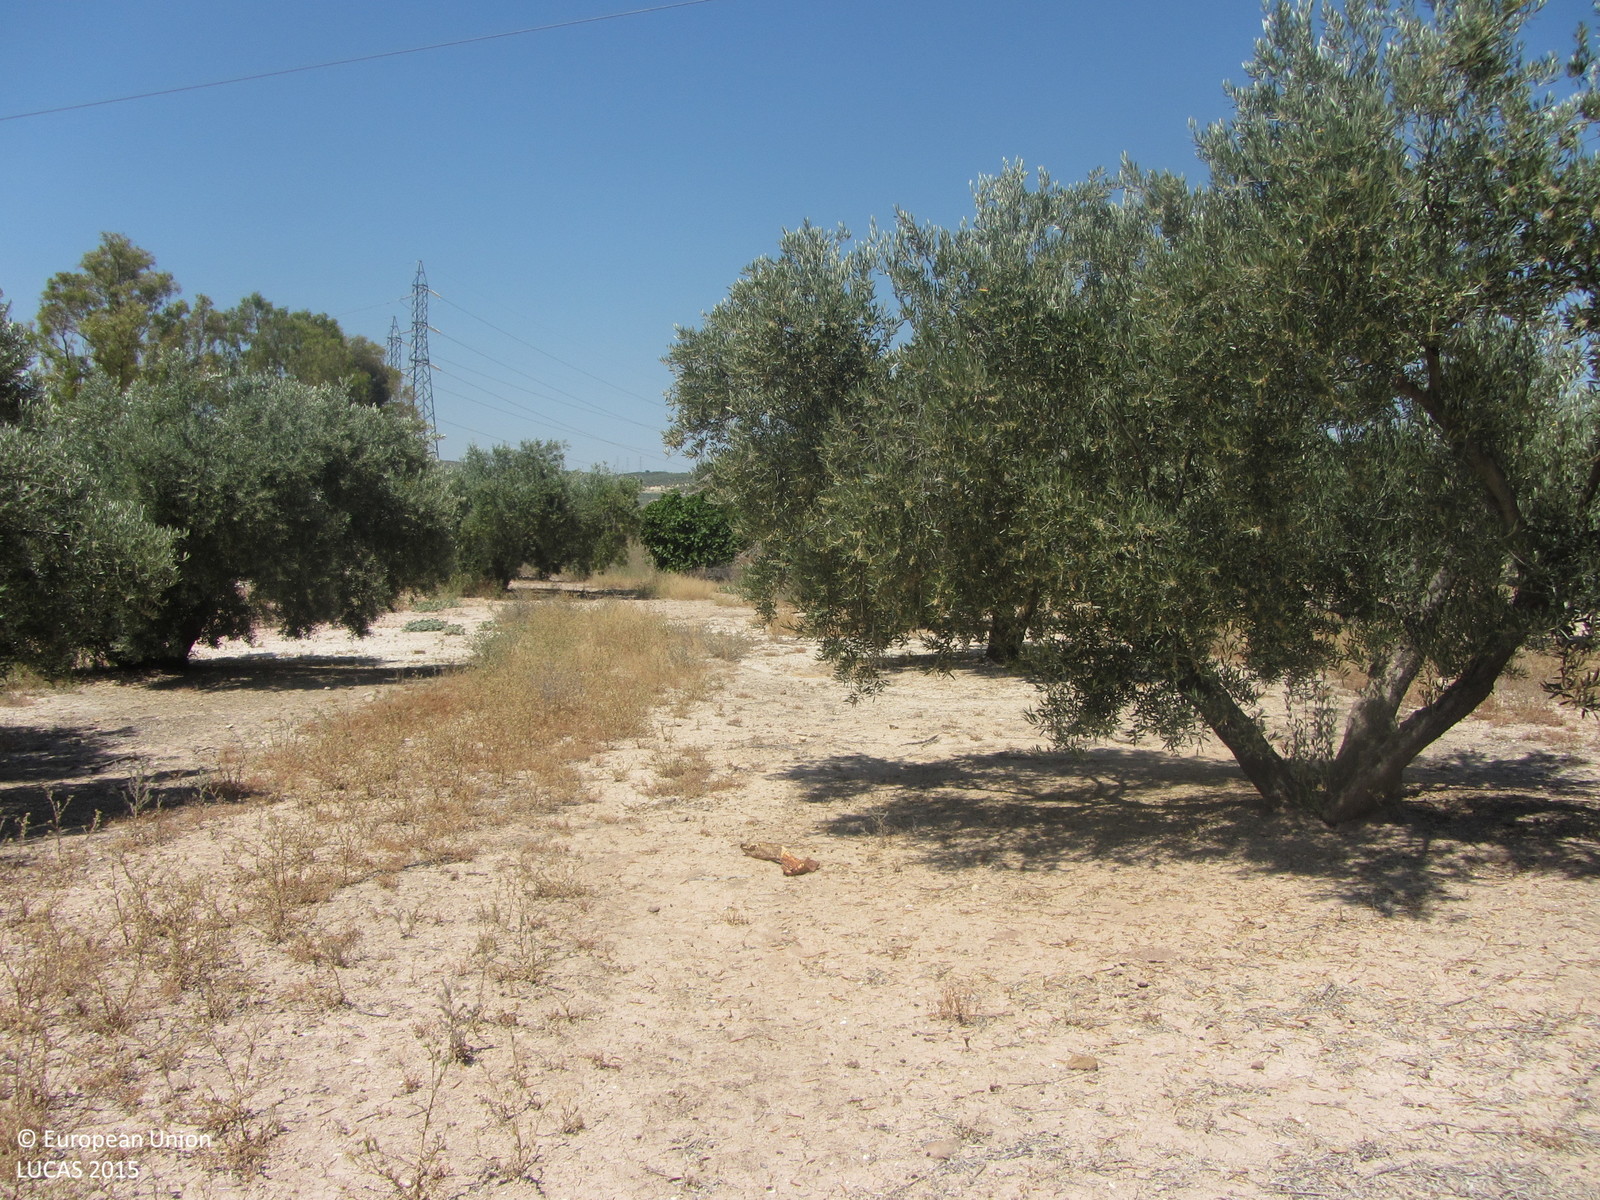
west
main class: Cropland
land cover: Olive groves
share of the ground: 25 - 50 %
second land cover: Spontaneously vegetated surfaces
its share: 10 - 25 %
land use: Agriculture (excluding fallow land and kitchen gardens)
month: June
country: ES
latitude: 37.8012
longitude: -3.8004
